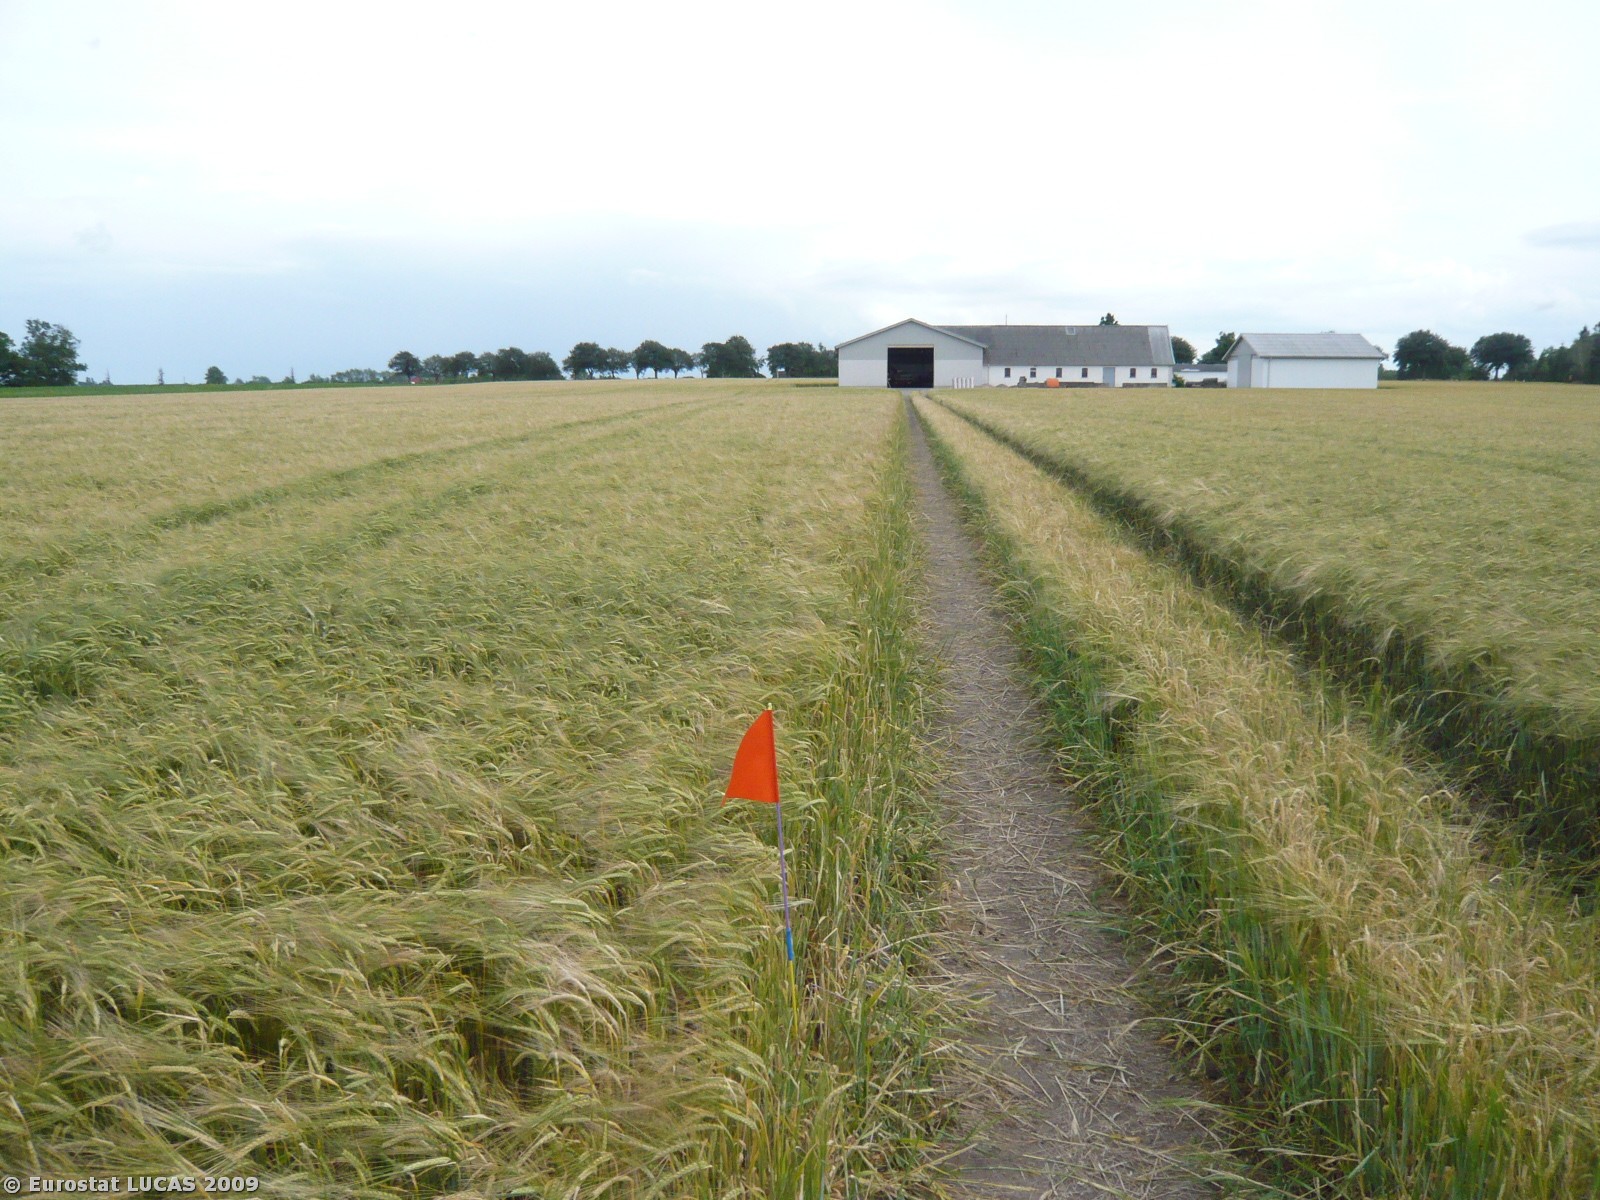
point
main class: Cropland
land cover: Barley
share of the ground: > 75 %
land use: Agriculture (excluding fallow land and kitchen gardens)
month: July
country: DK
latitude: 55.4449
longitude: 11.2162
